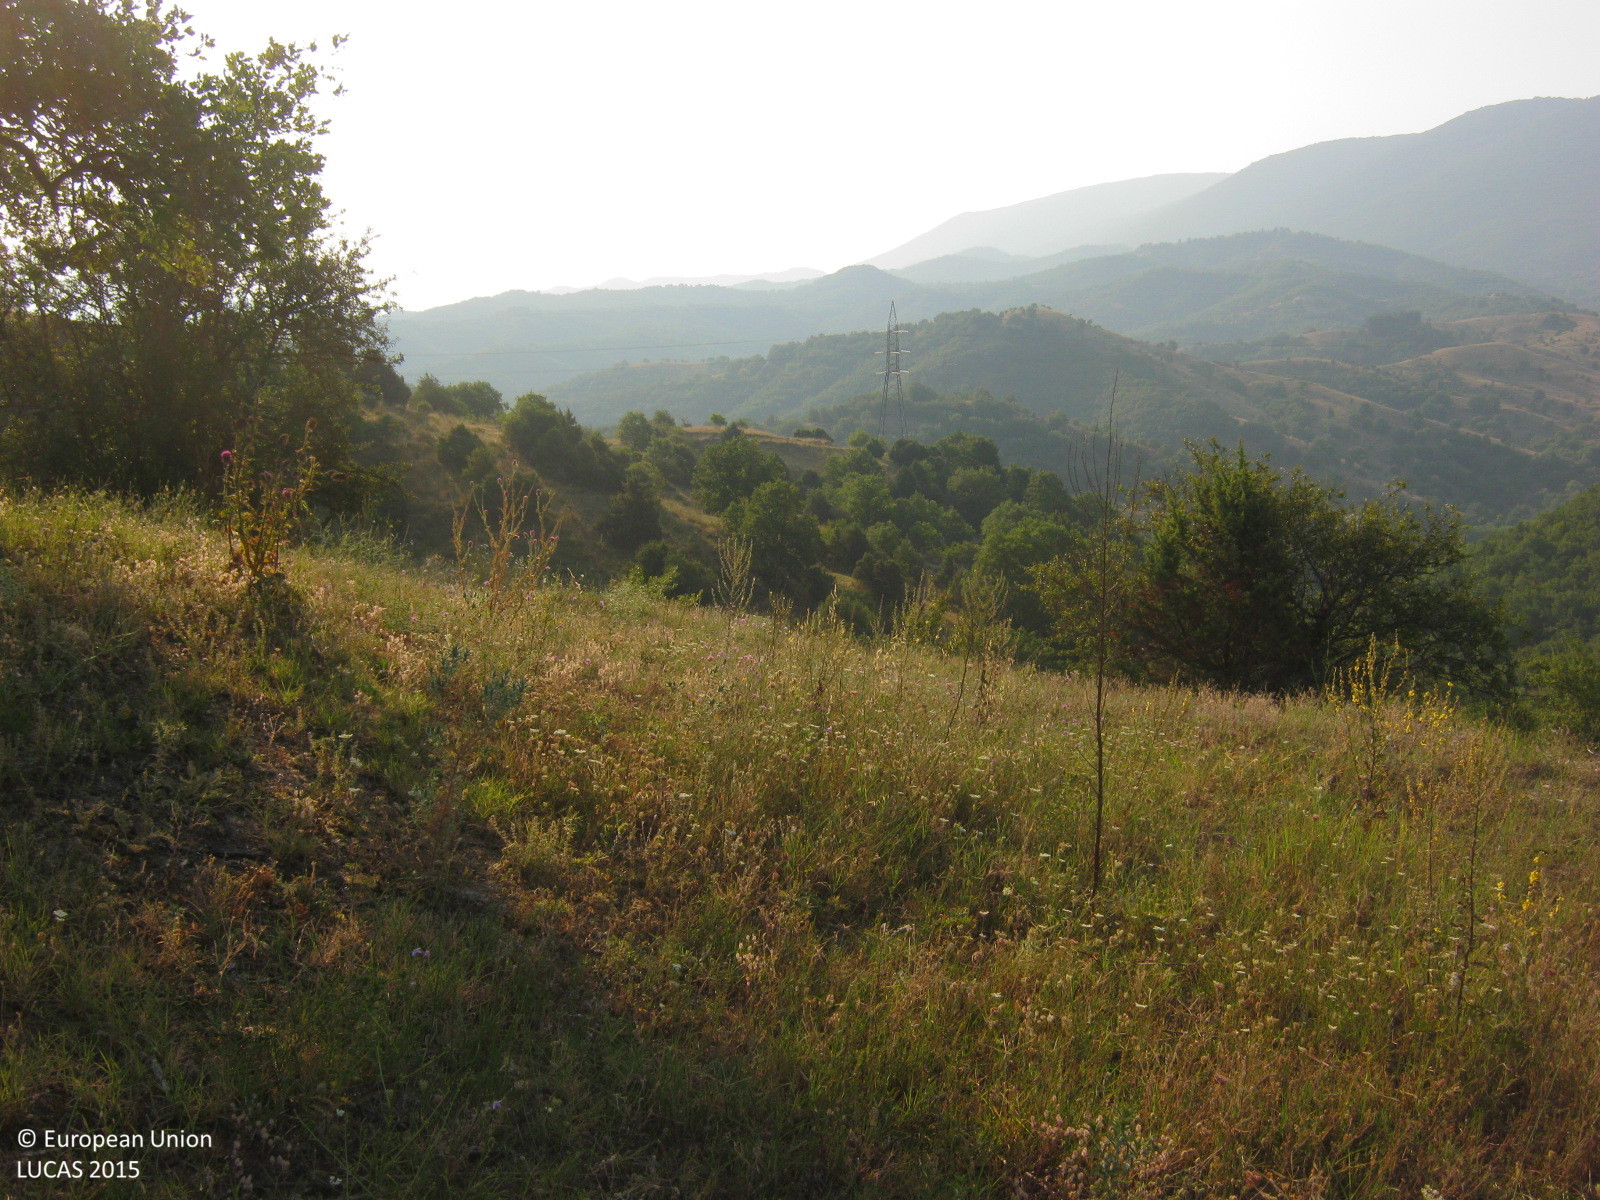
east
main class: Woodland
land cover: Broadleaved woodland
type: thermophilous deciduous forest
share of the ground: 25 - 50 %
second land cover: Spontaneously vegetated surfaces
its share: > 75 %
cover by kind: herbaceous plants 60 %, broadleaved forest trees 40 %
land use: Forestry
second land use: Agriculture (excluding fallow land and kitchen gardens)
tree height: > 5 m
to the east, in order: Broadleaved woodland; Spontaneously vegetated surfaces; Broadleaved woodland; Grassland with sparse tree/shrub cover
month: July
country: GR
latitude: 41.2469
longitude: 24.4385
